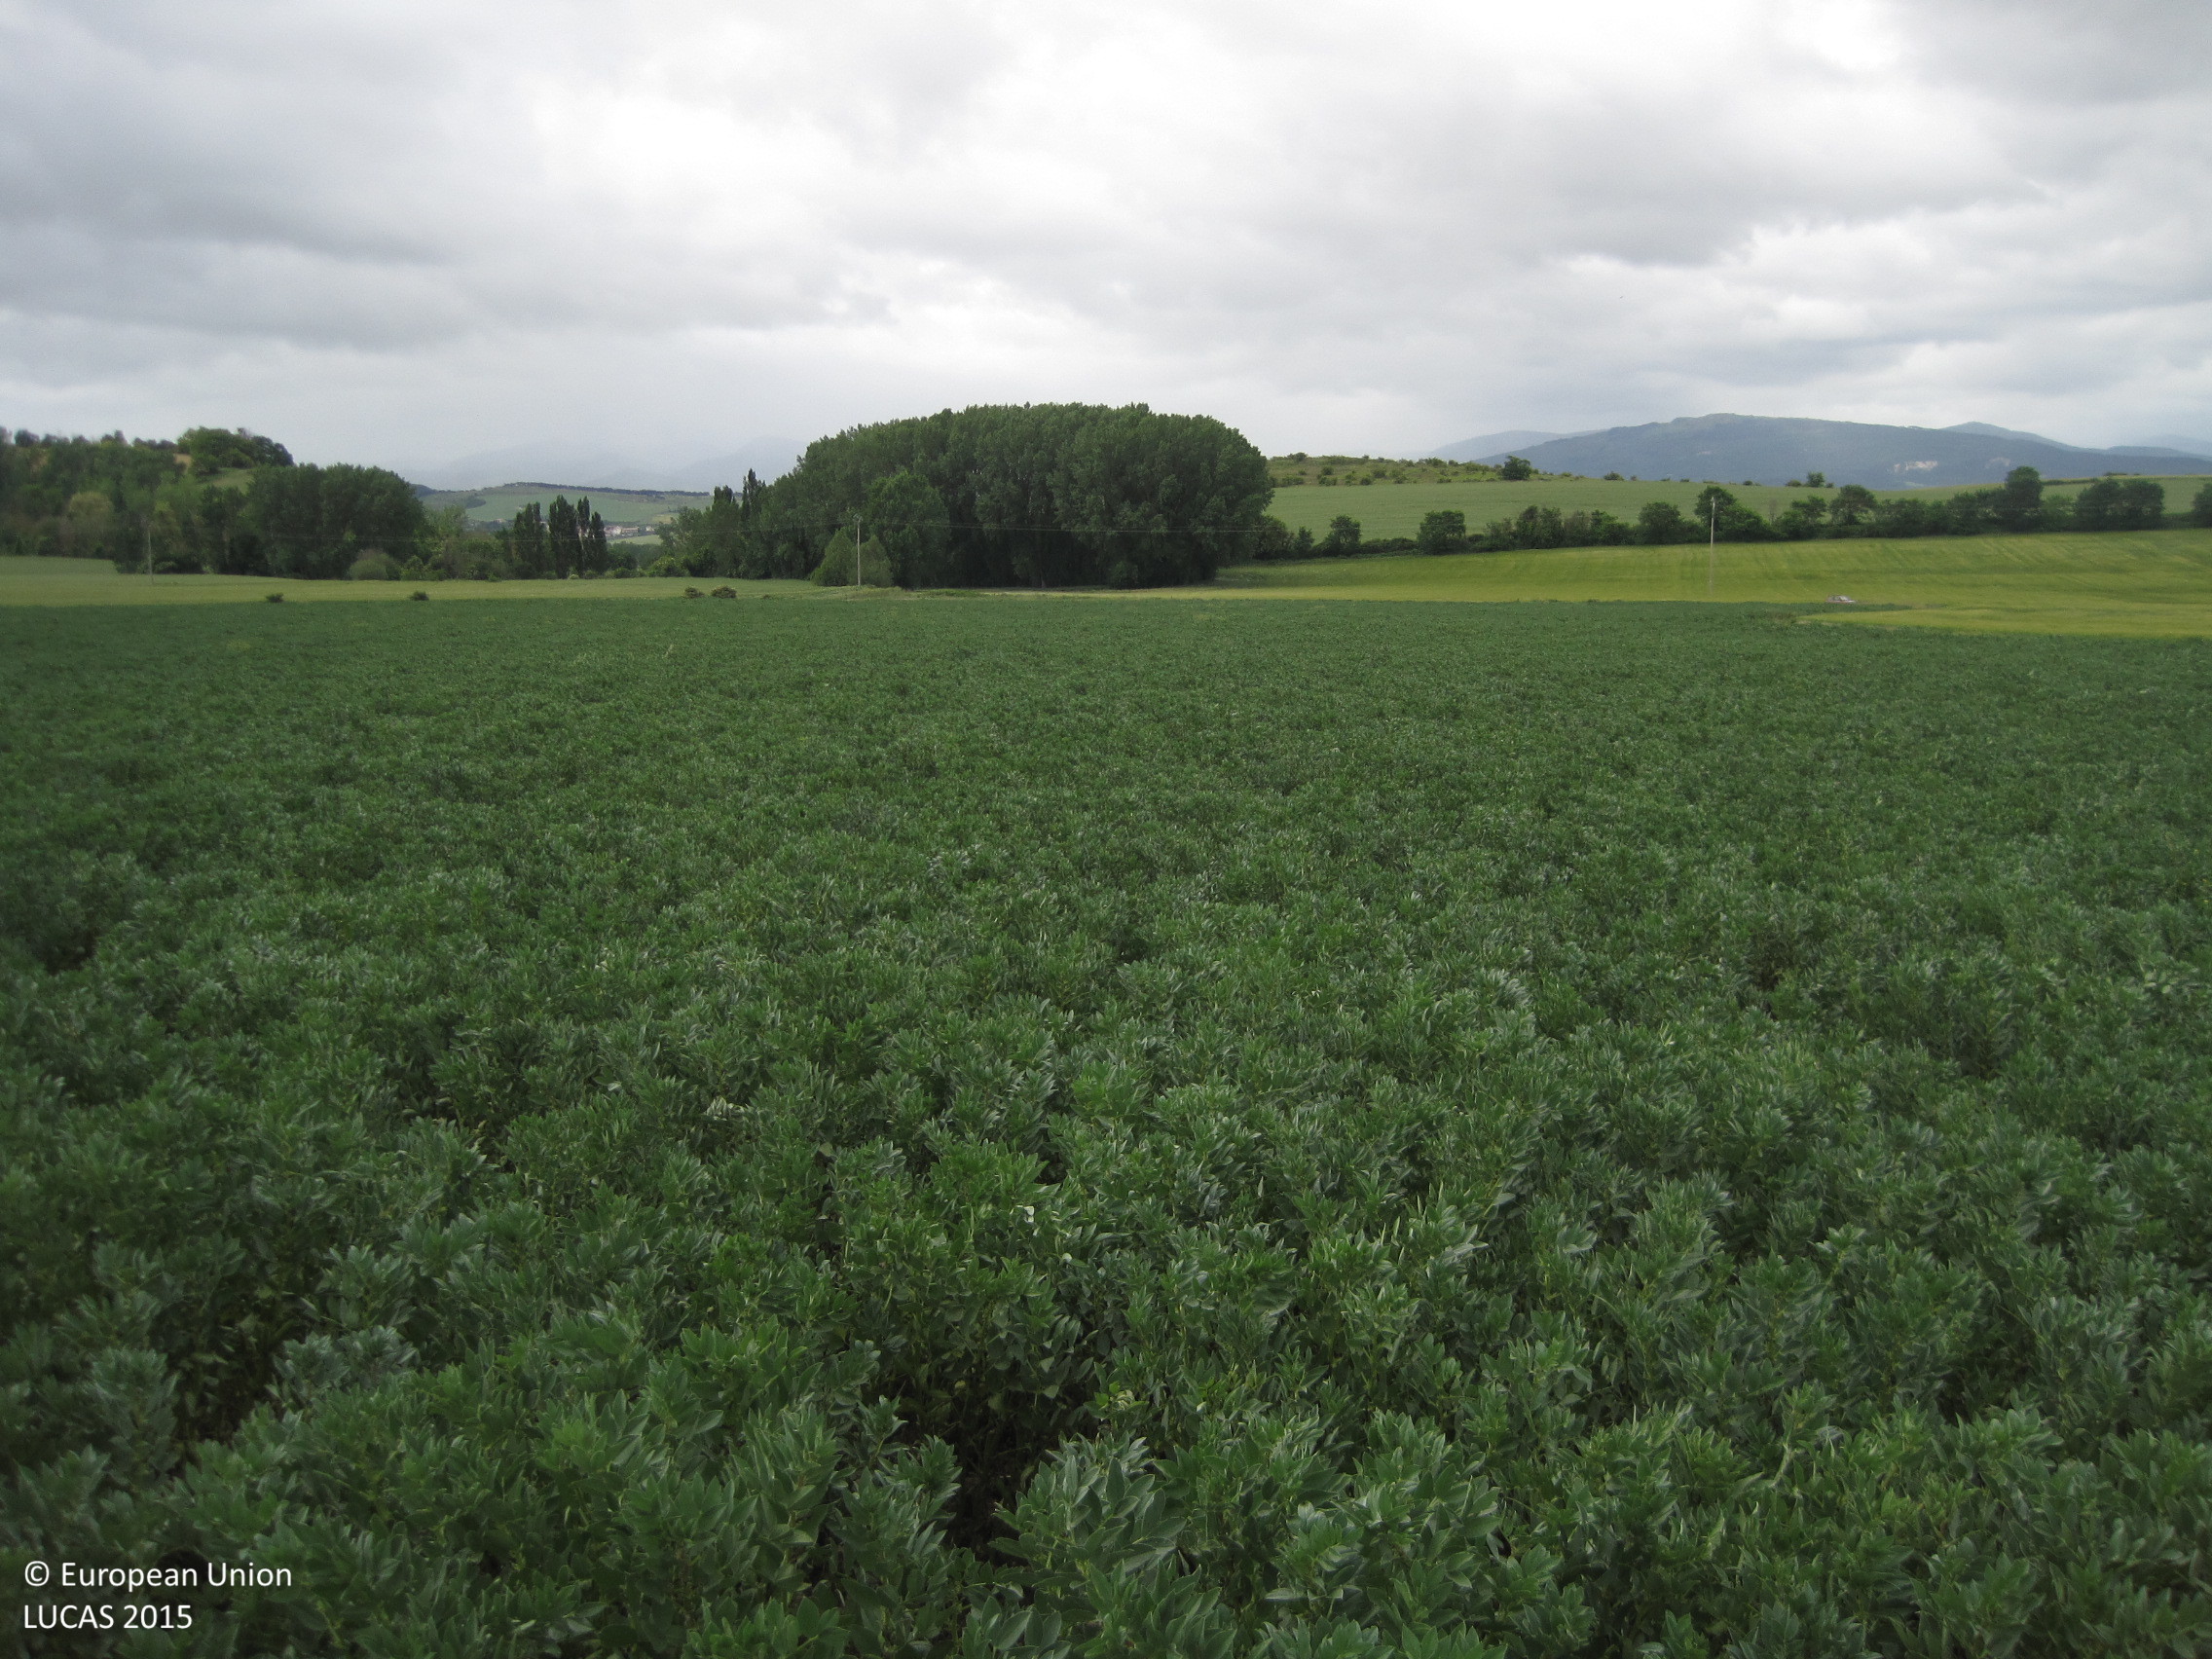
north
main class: Cropland
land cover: Dry pulses
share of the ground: > 75 %
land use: Agriculture (excluding fallow land and kitchen gardens)
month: May
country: ES
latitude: 42.7563
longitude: -1.7079
